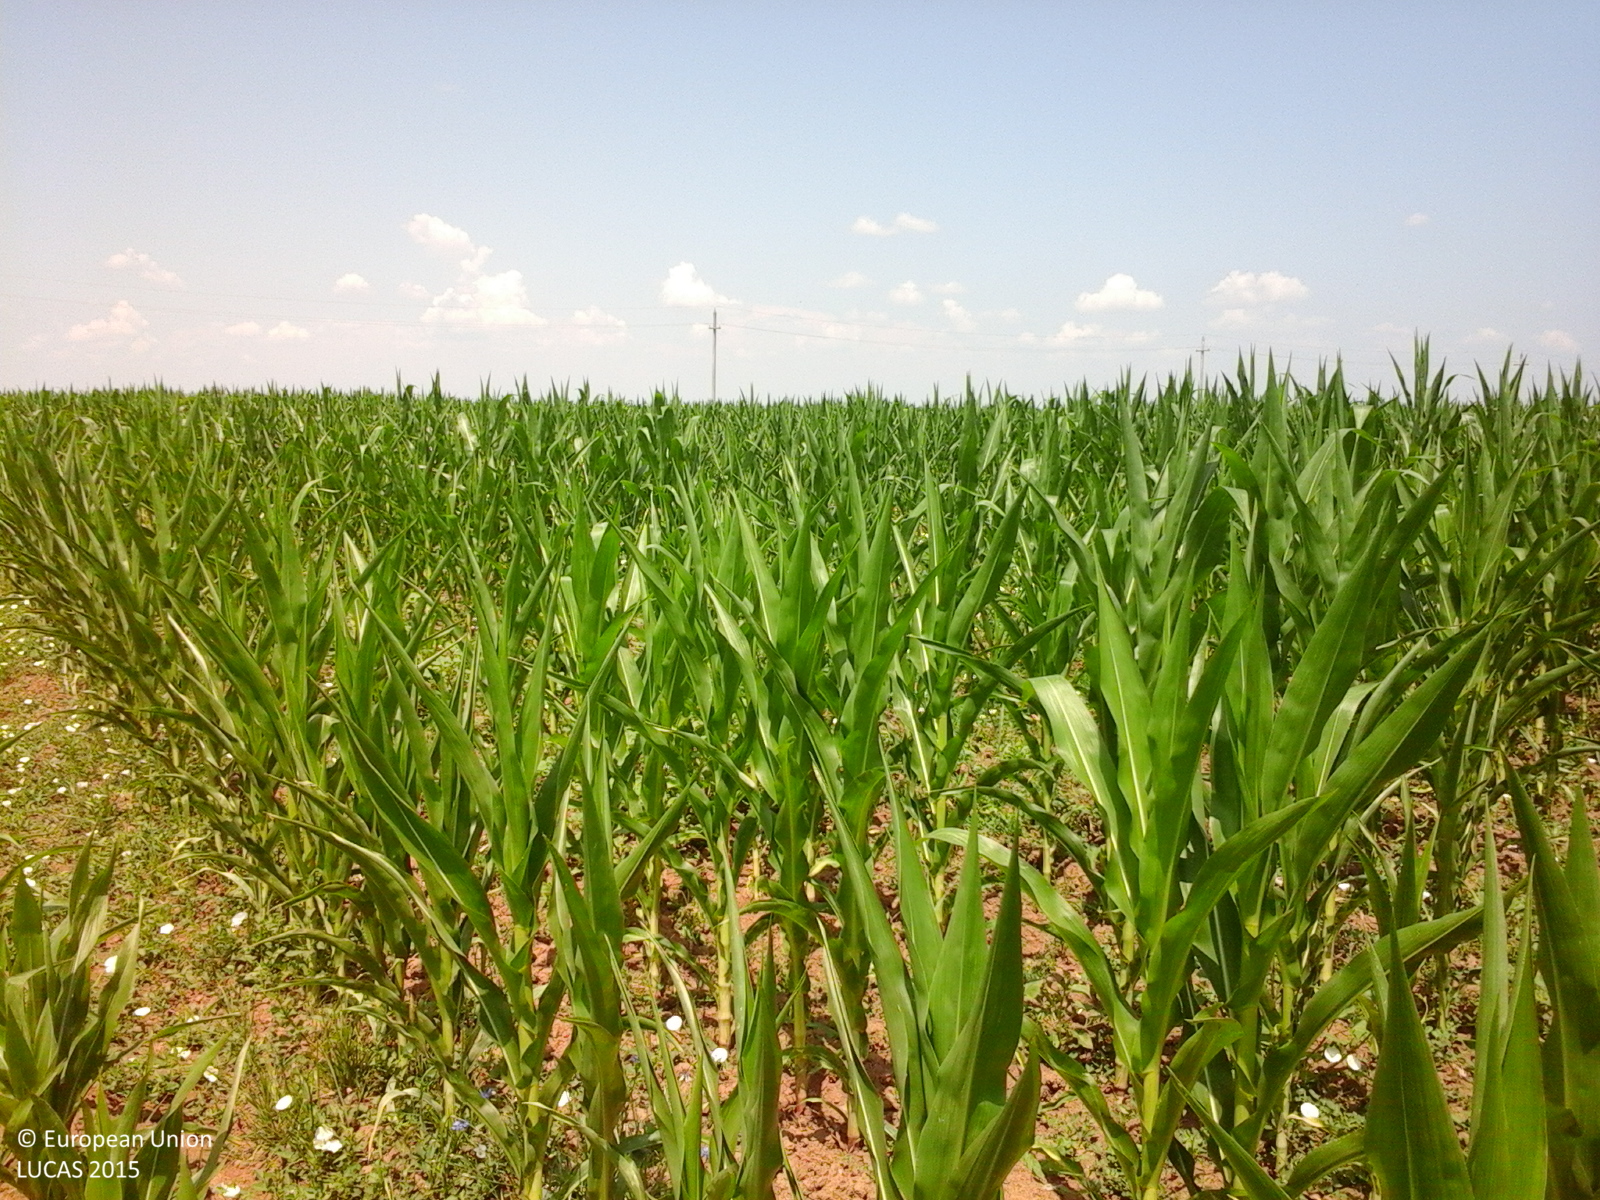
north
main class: Cropland
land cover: Maize
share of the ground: > 75 %
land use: Agriculture (excluding fallow land and kitchen gardens)
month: July
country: RO
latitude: 44.3651
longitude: 25.7691
